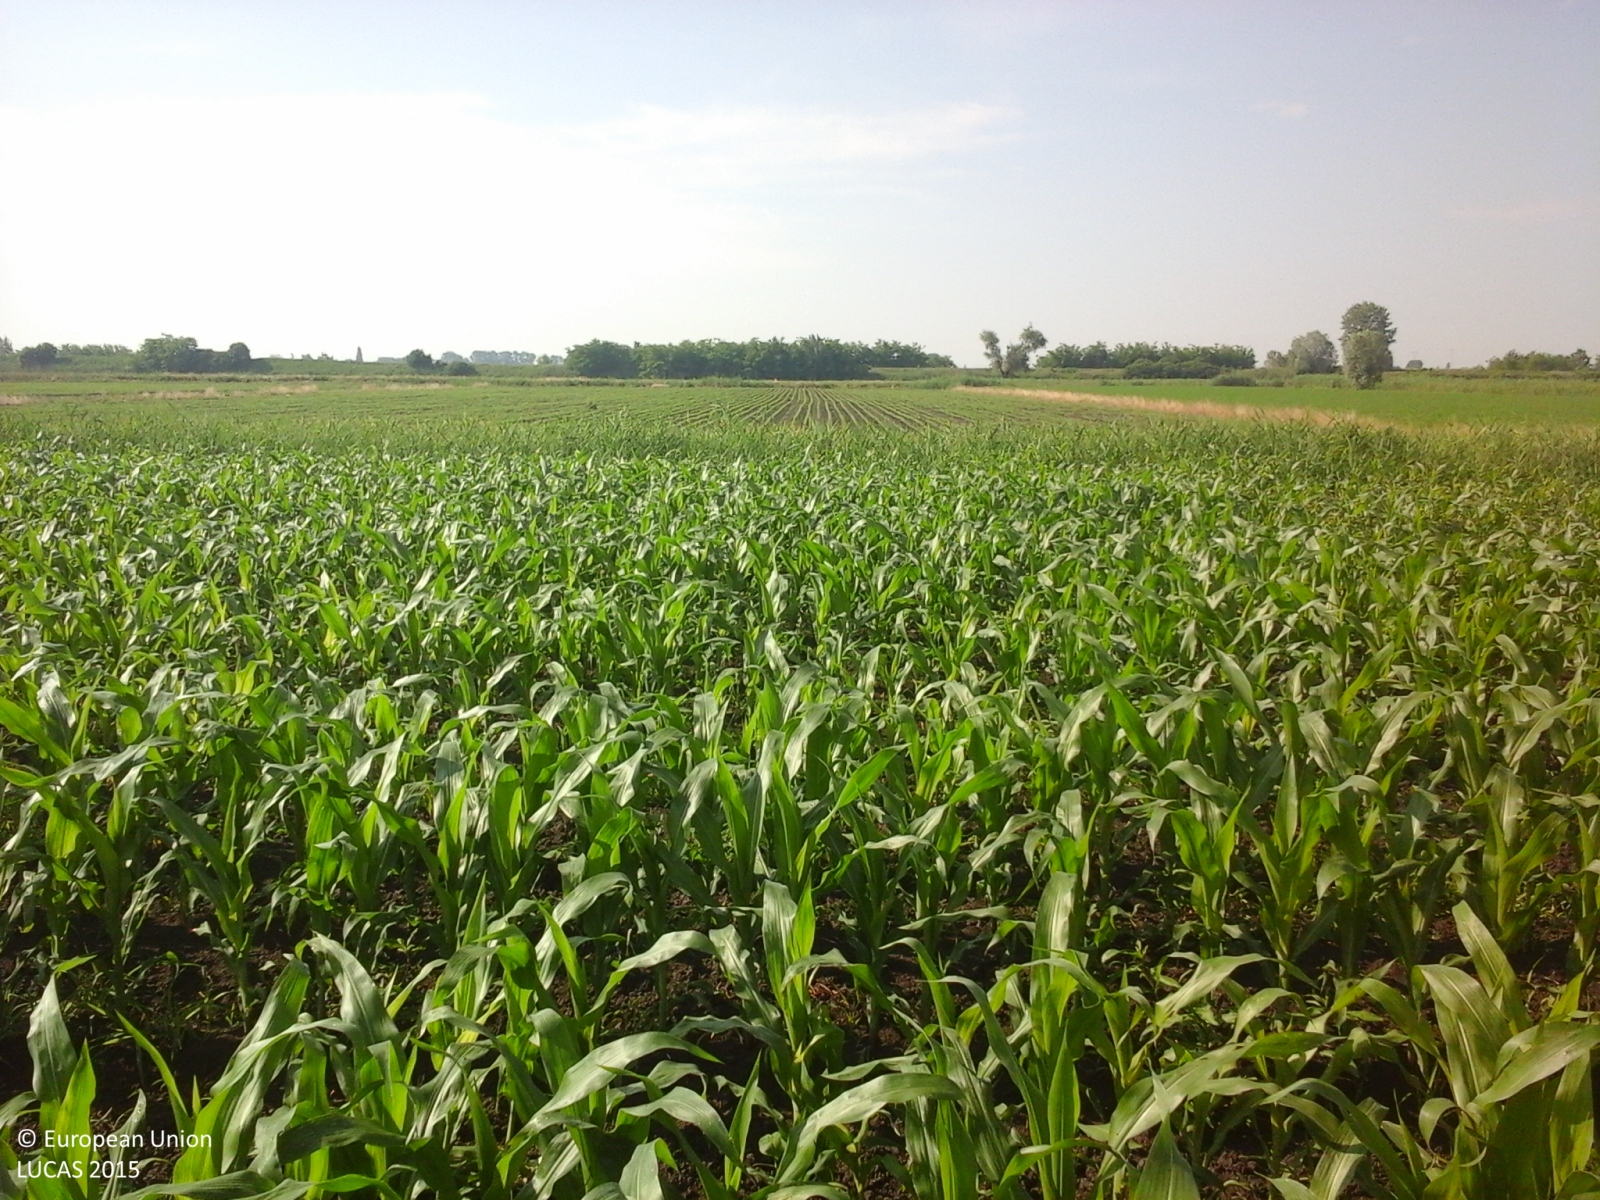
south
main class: Cropland
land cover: Maize
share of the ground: 50 - 75 %
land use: Agriculture (excluding fallow land and kitchen gardens)
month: May
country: IT
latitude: 45.1012
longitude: 11.1797
